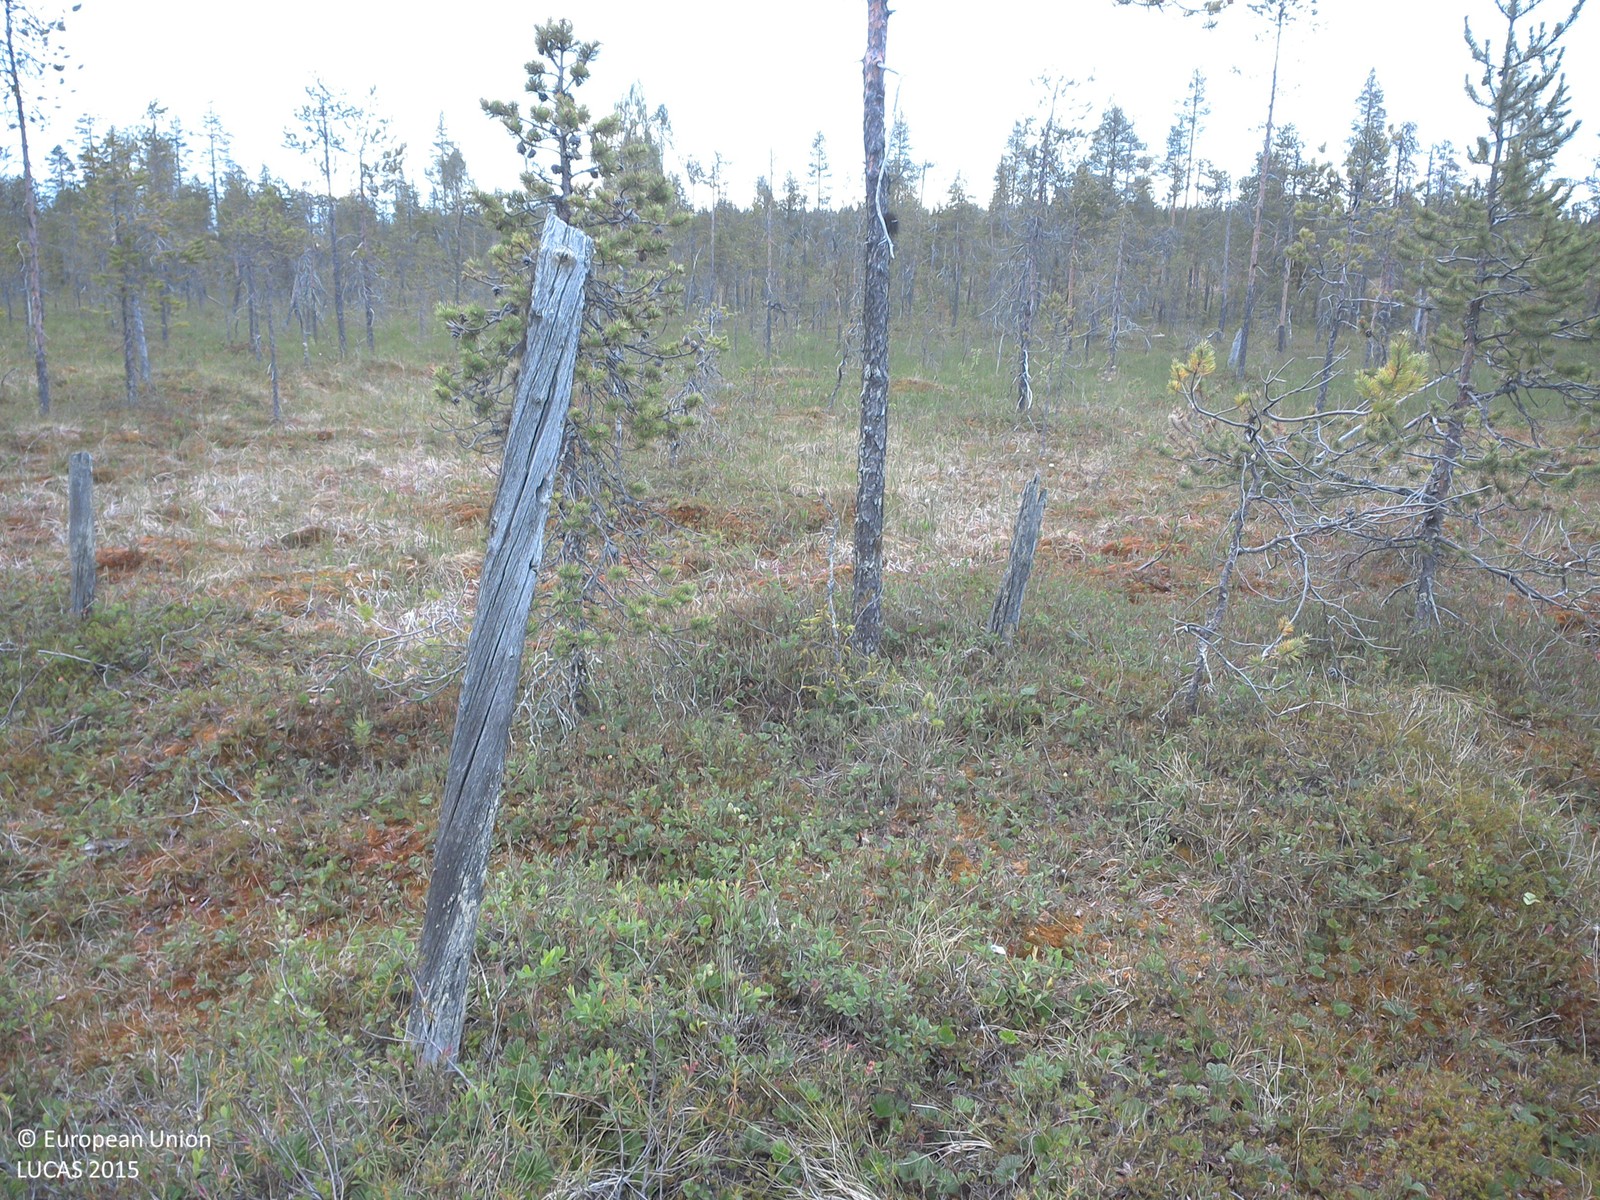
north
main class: Woodland
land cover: Pine dominated coniferous woodland
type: boreal forest
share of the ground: 10 - 25 %
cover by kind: lichens and mosses 45 %, herbaceous plants 25 %, shrubs 20 %, coniferous forest trees 10 %
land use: Amenities, museums, leisure
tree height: < 5 m
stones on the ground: < 10 %
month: July
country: SE
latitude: 66.8755
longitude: 23.0012
